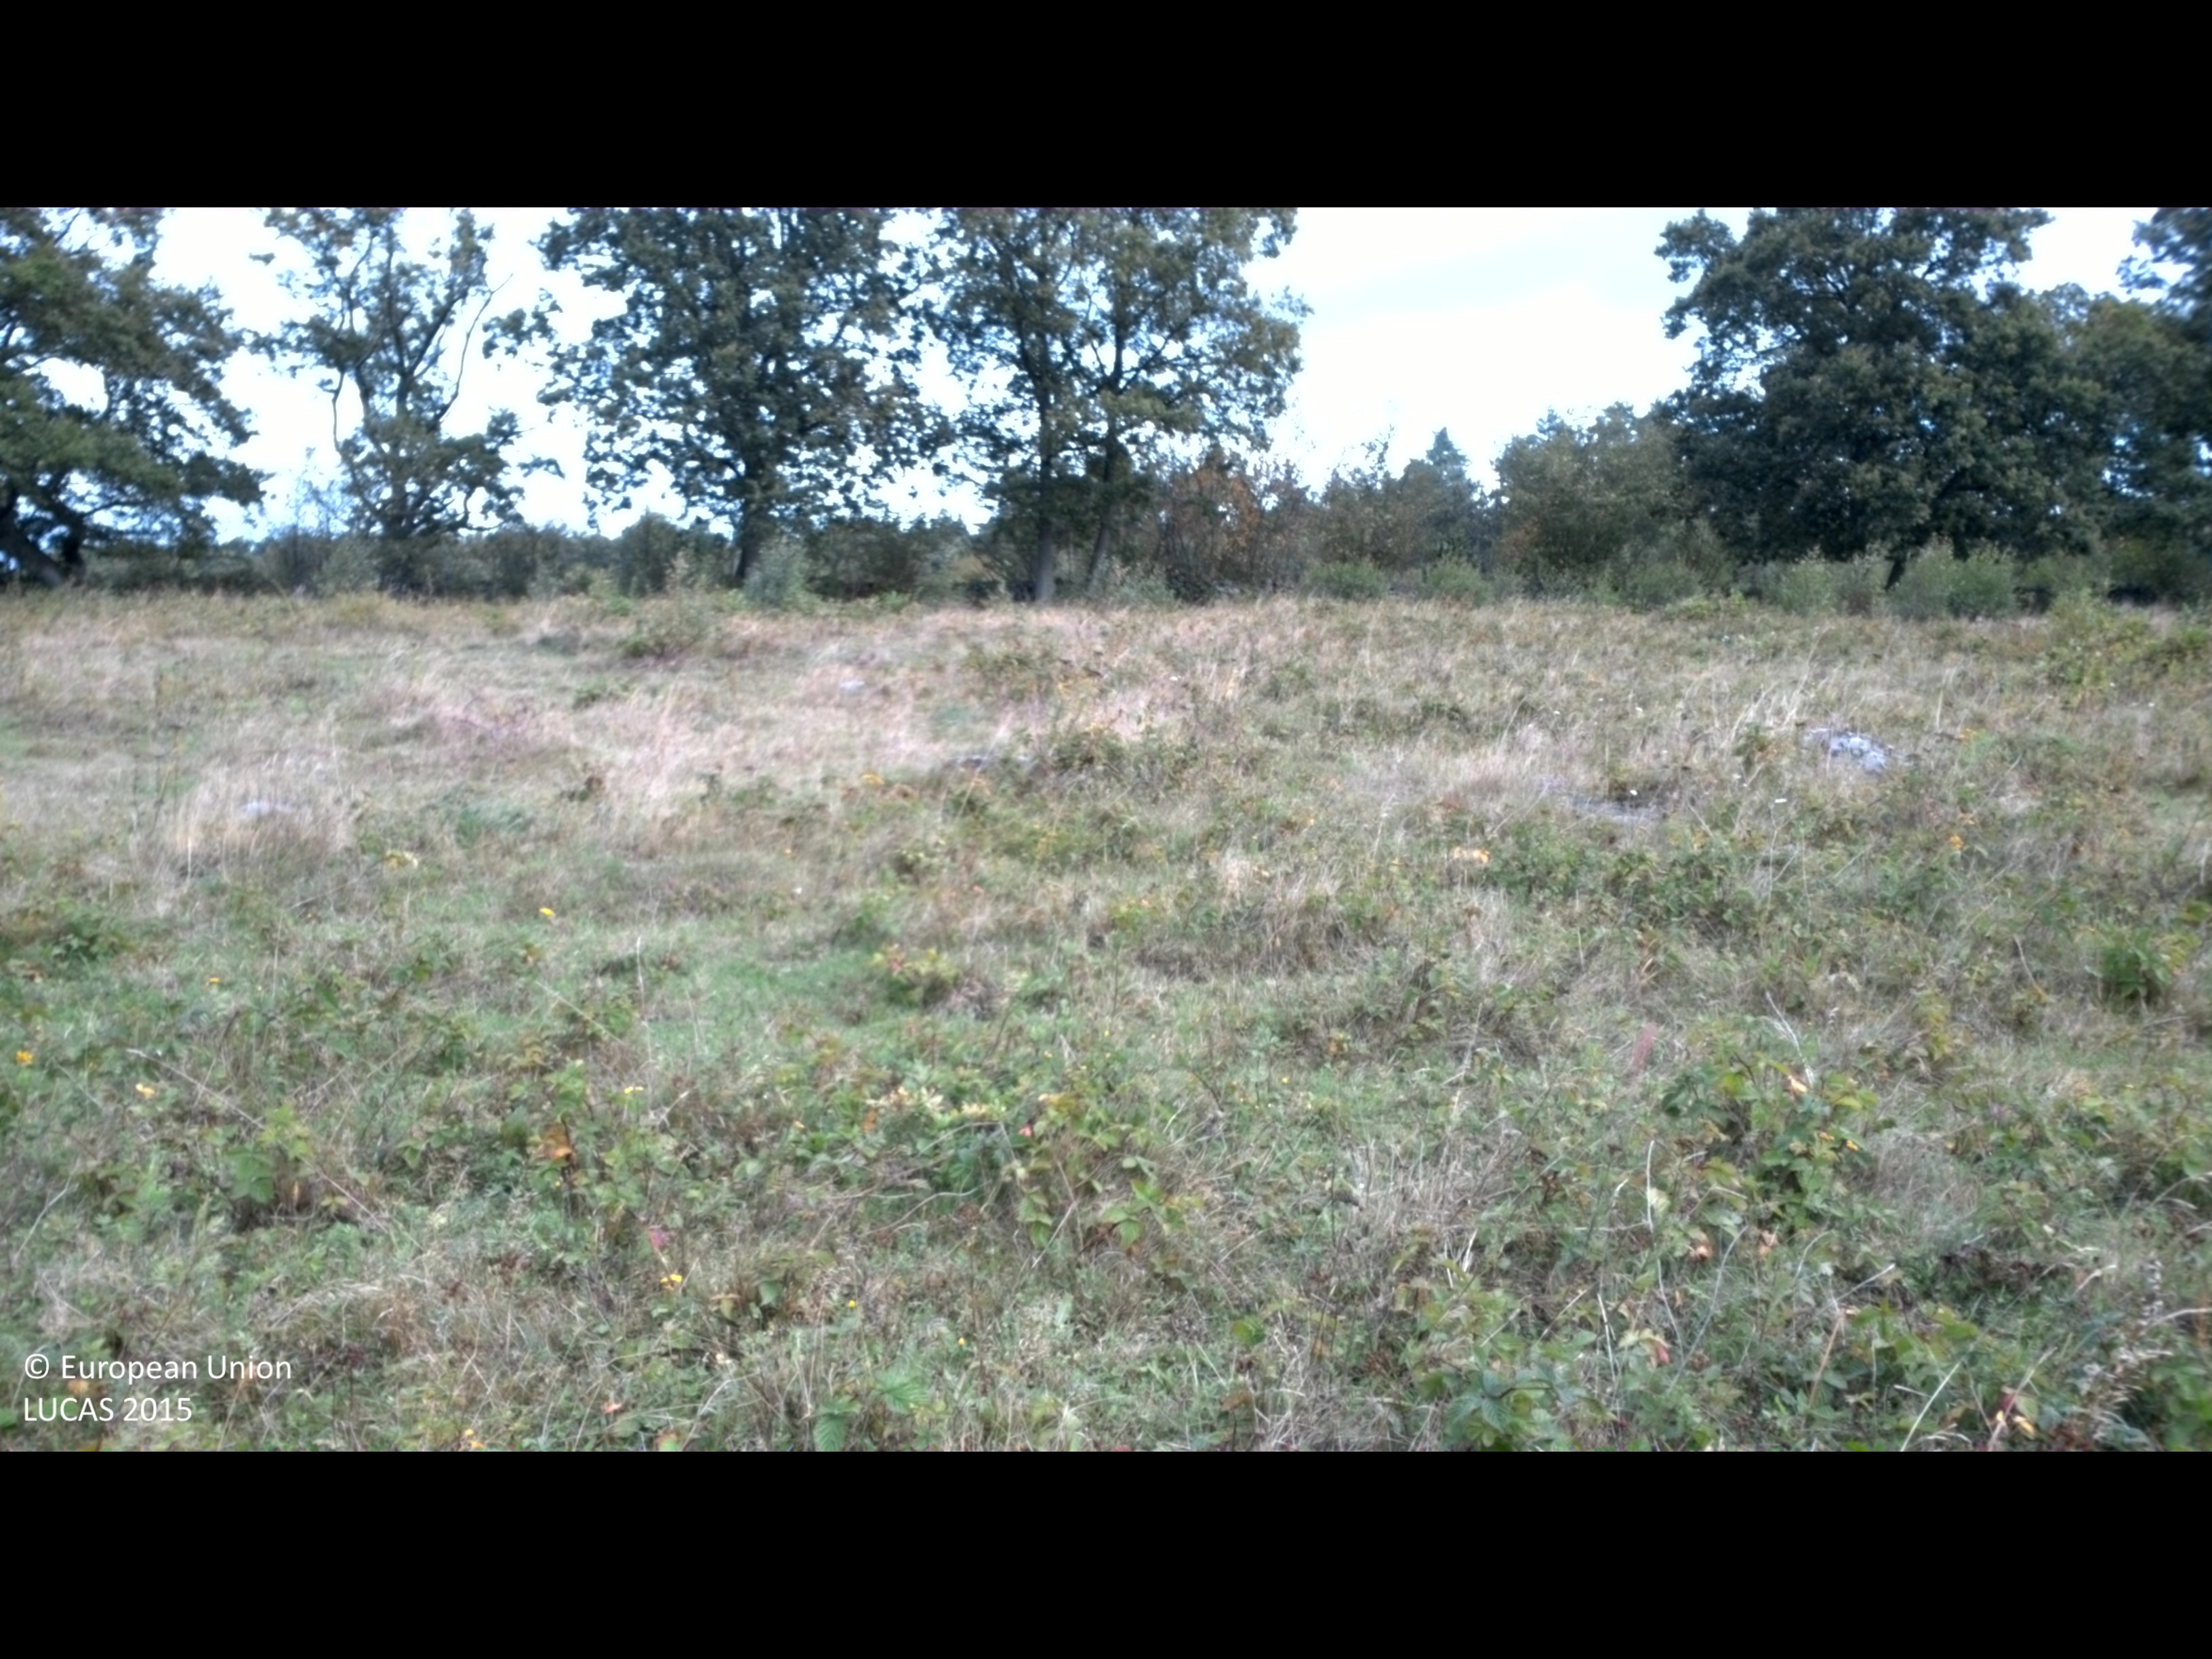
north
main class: Grassland
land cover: Grassland without tree/shrub cover
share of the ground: > 75 %
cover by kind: herbaceous plants 95 %, shrubs 5 %
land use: Agriculture (excluding fallow land and kitchen gardens)
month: September
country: SE
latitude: 56.0702
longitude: 14.5765
